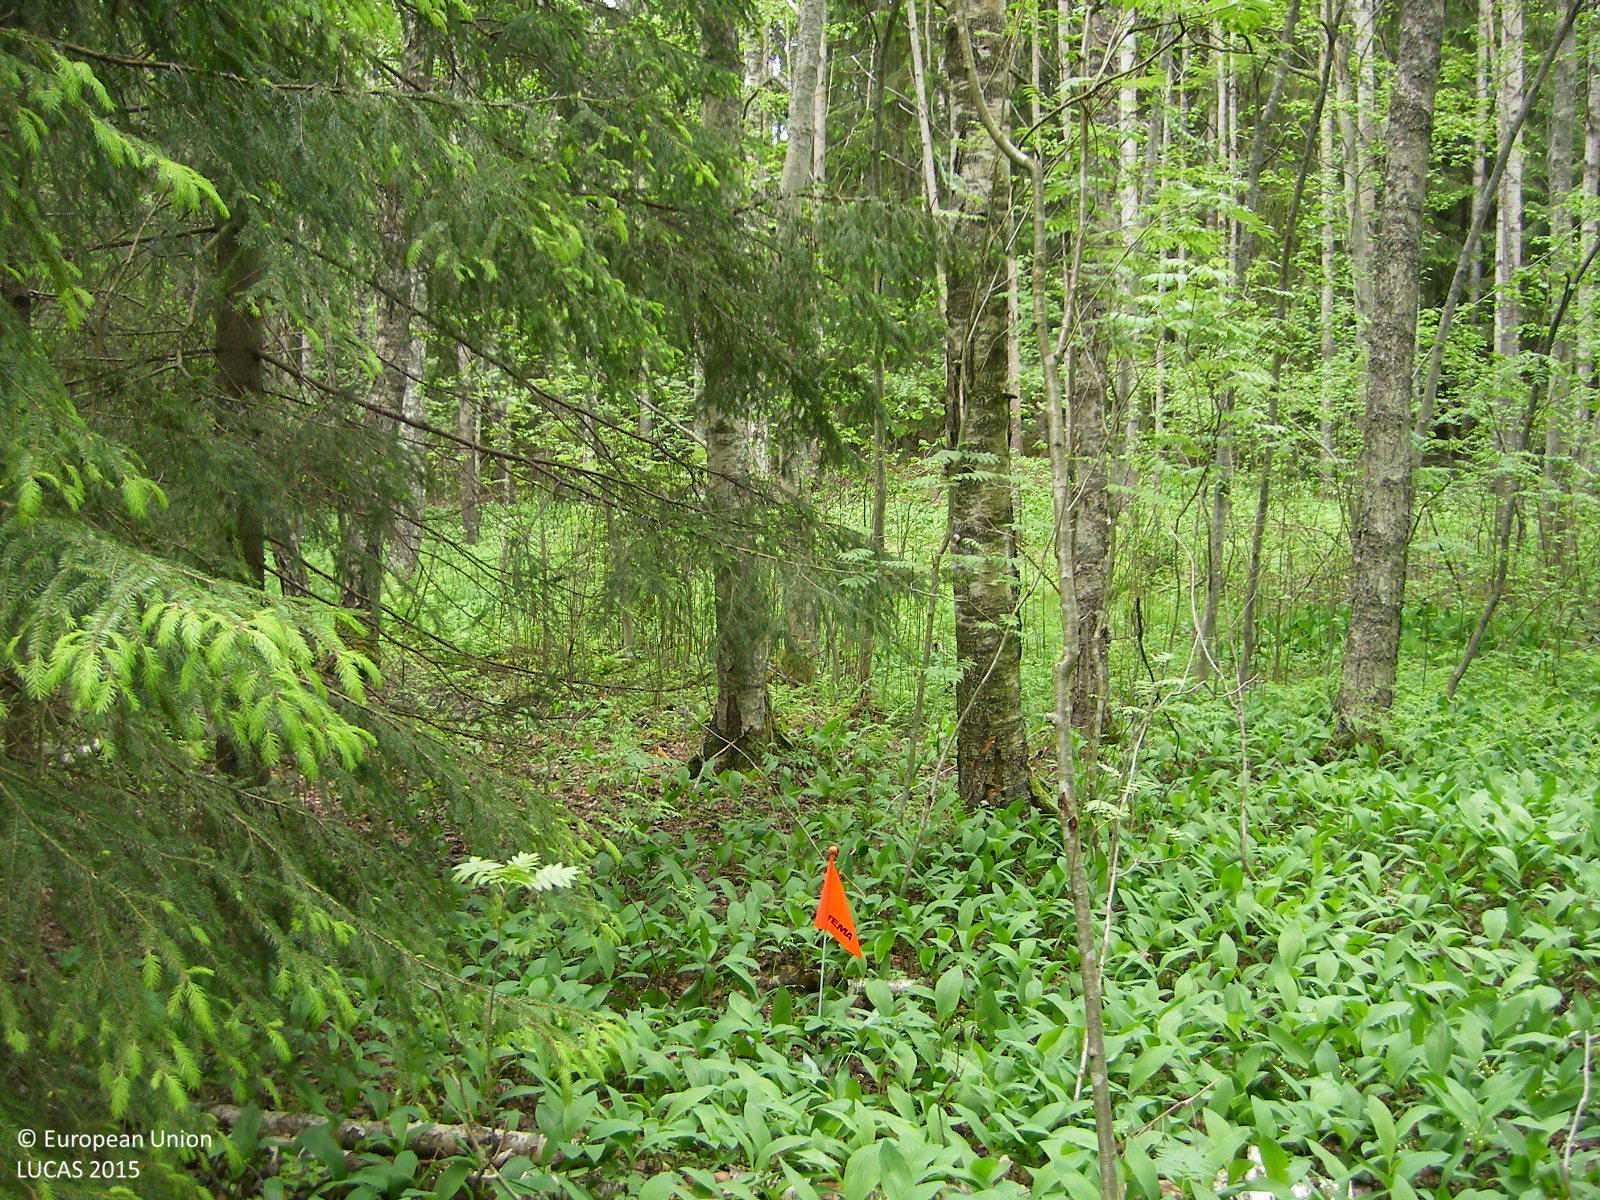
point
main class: Woodland
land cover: Spruce dominated mixed woodland
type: boreal forest
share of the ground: > 75 %
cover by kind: broadleaved forest trees 50 %, coniferous forest trees 40 %, herbaceous plants 10 %
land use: Semi-natural and natural areas not in use
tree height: > 5 m
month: June
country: FI
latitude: 60.1935
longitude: 24.7037
